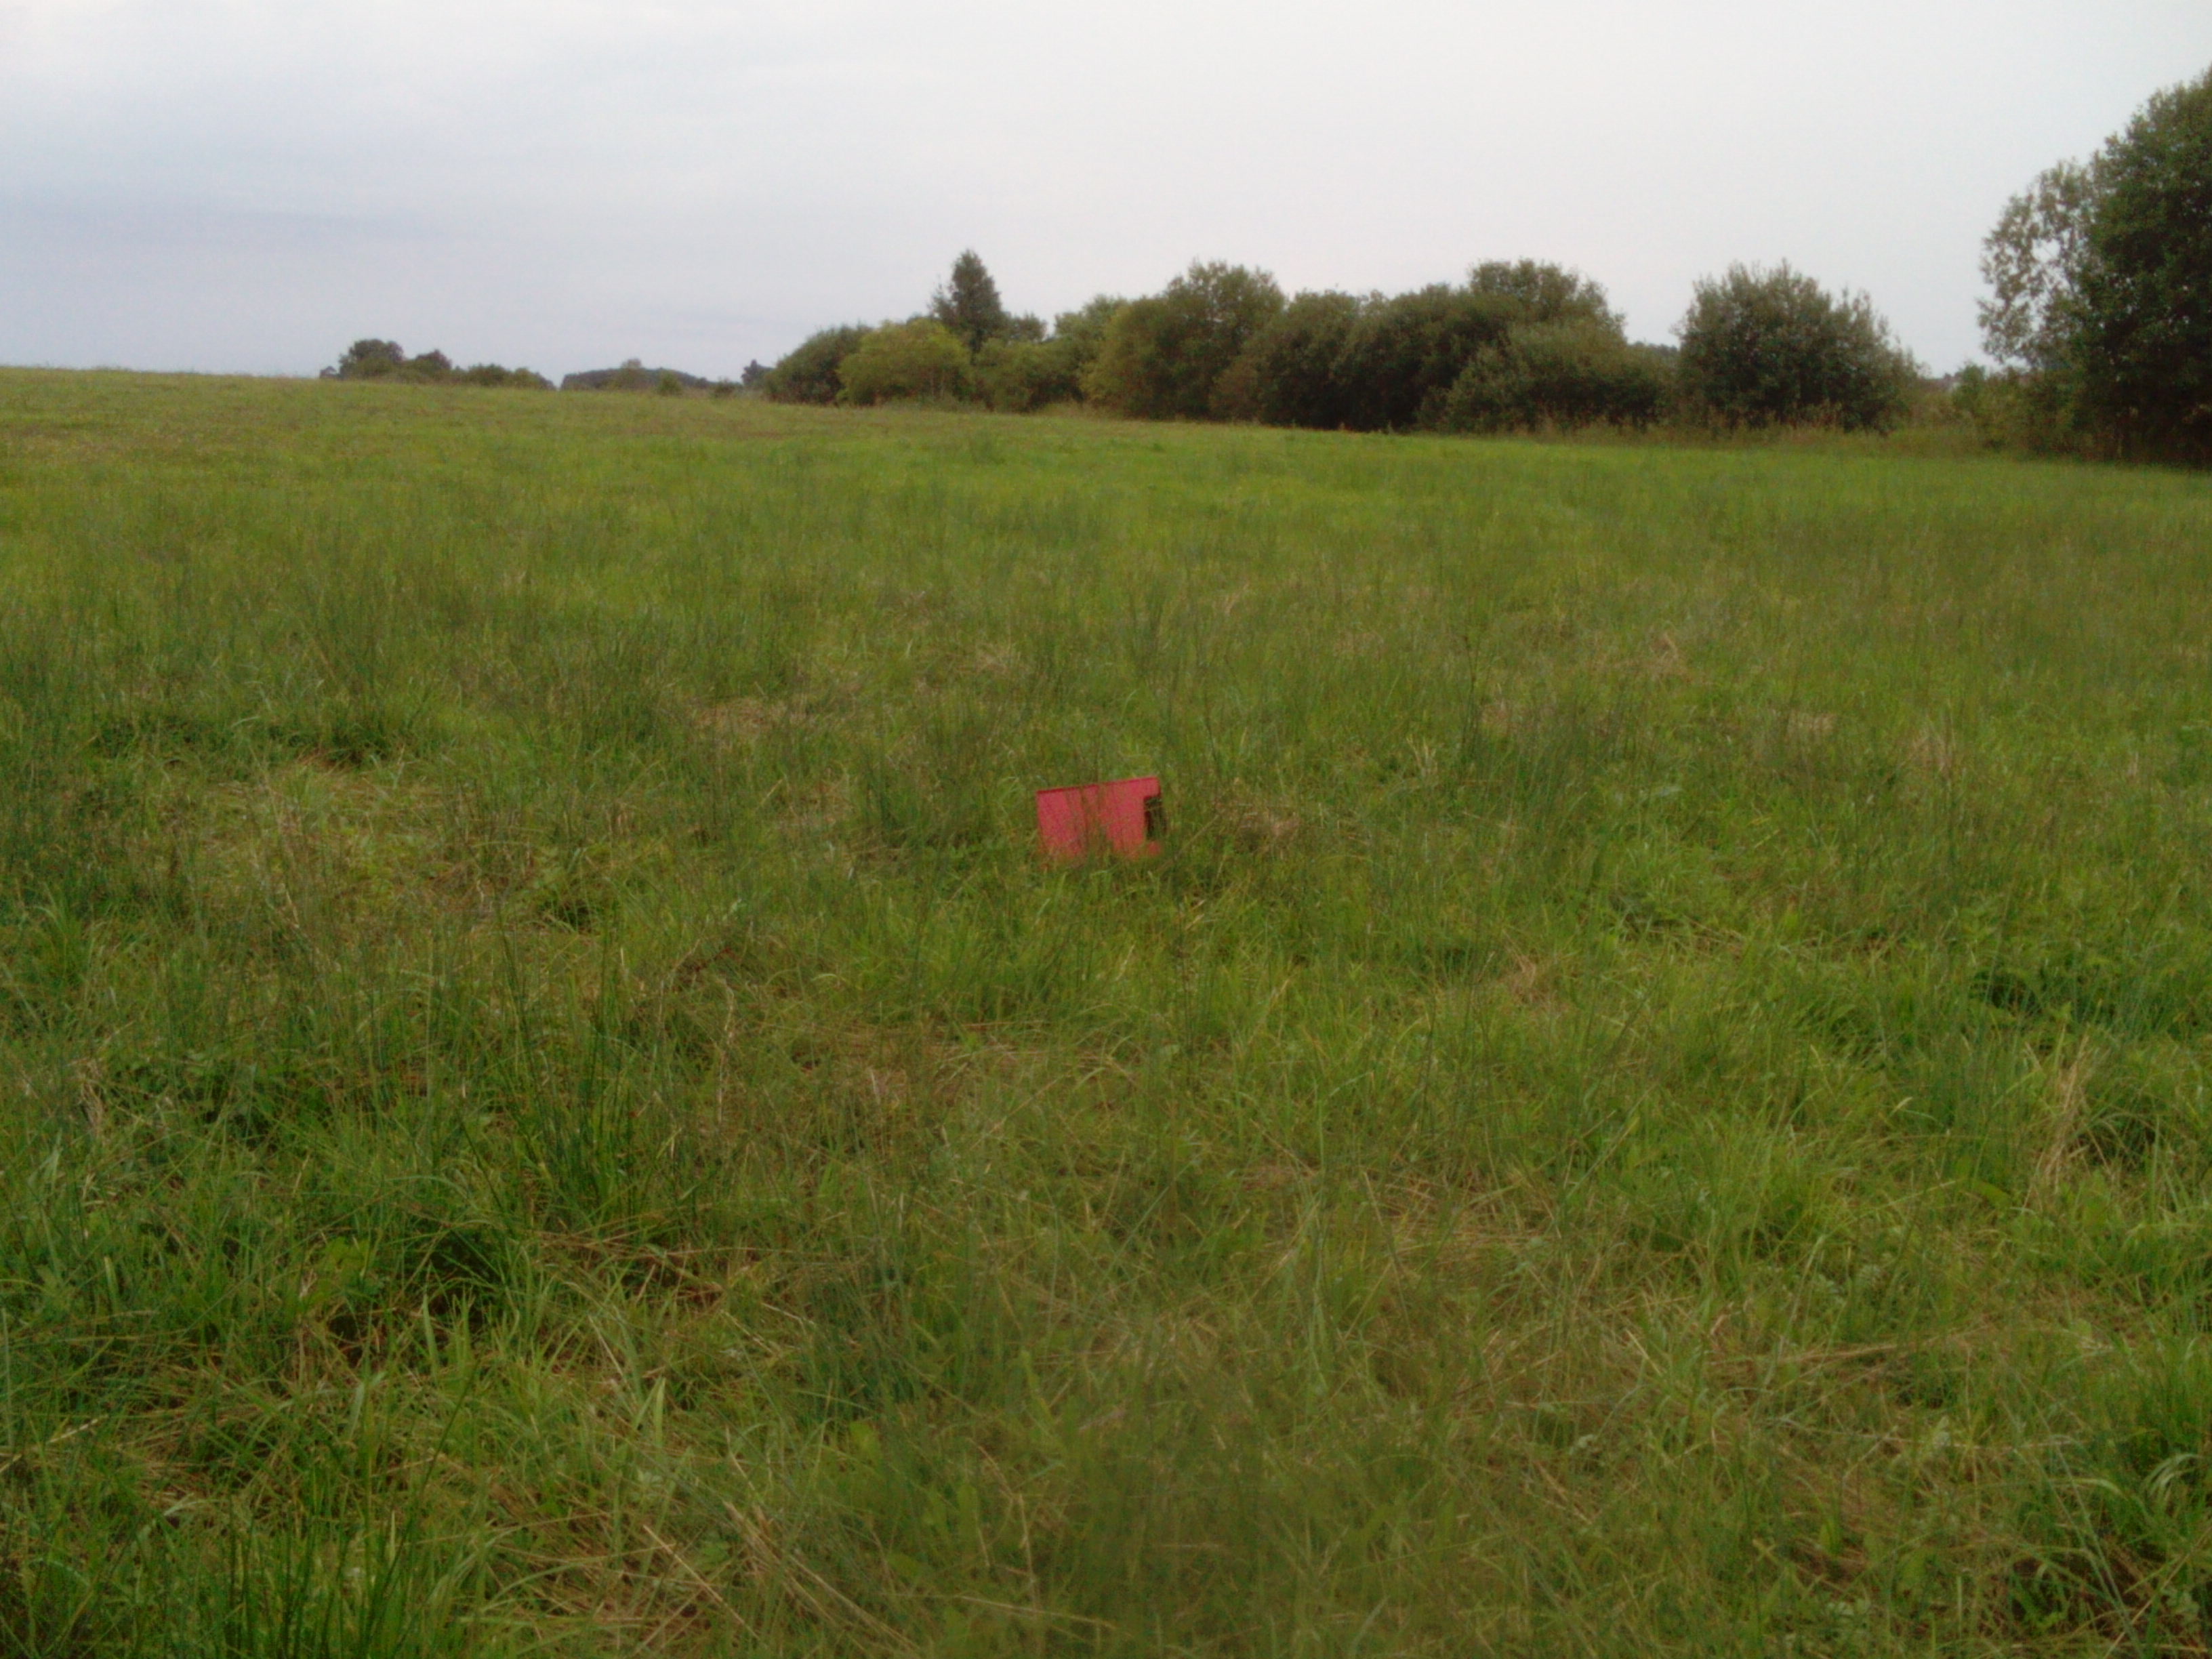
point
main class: Grassland
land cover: Grassland without tree/shrub cover
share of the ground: > 75 %
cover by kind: herbaceous plants 100 %
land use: Agriculture (excluding fallow land and kitchen gardens)
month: September
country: LT
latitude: 55.7156
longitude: 22.7187
